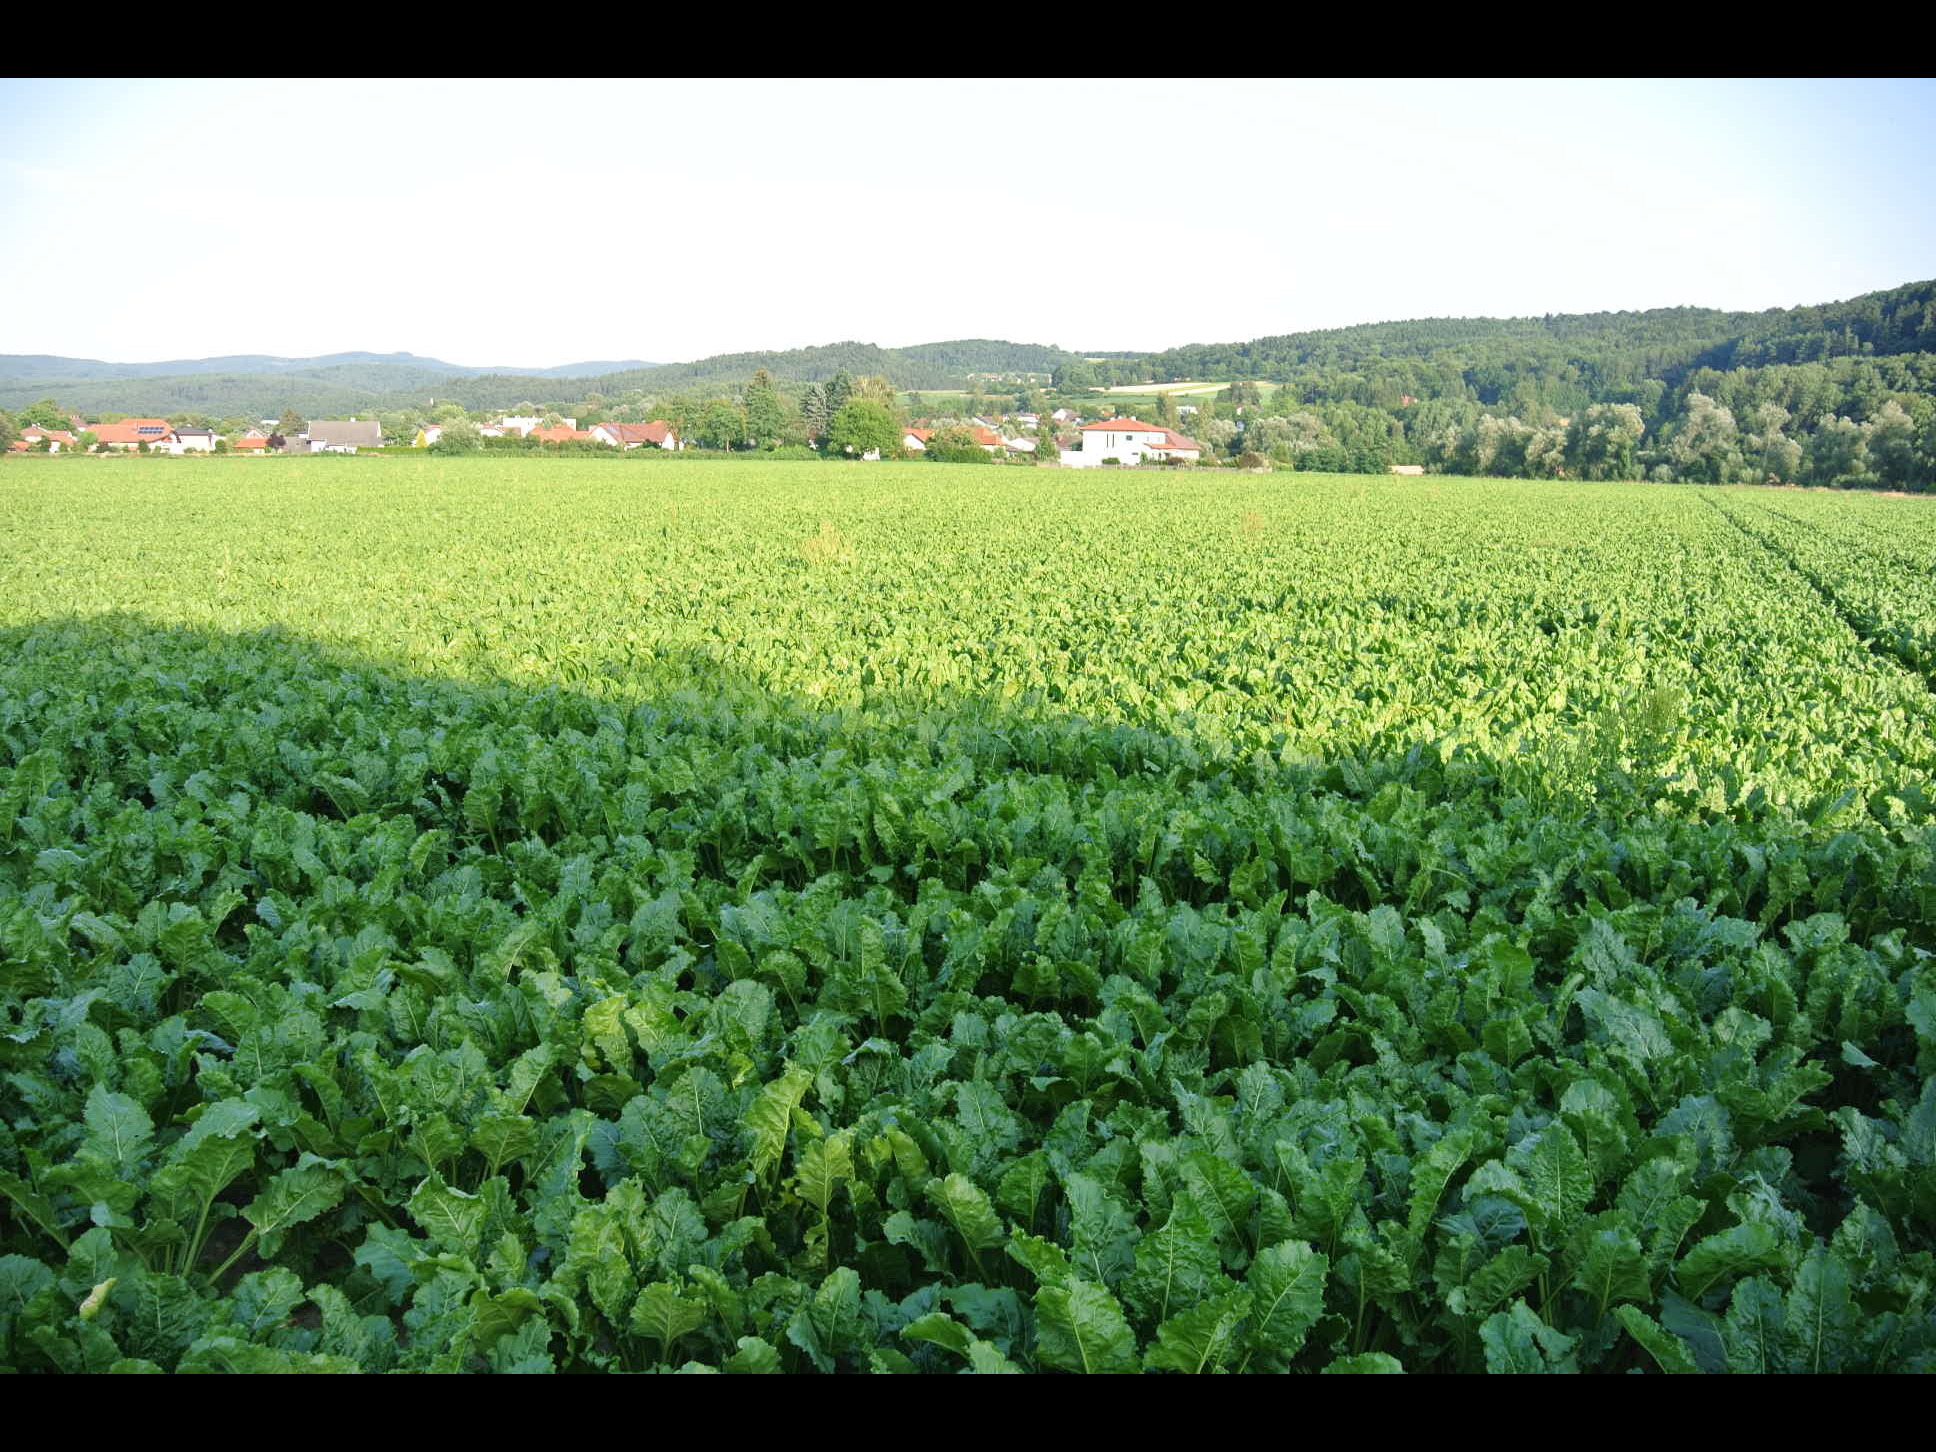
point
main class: Cropland
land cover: Sugar beet
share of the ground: > 75 %
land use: Agriculture (excluding fallow land and kitchen gardens)
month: July
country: AT
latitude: 47.7240
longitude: 16.2027
